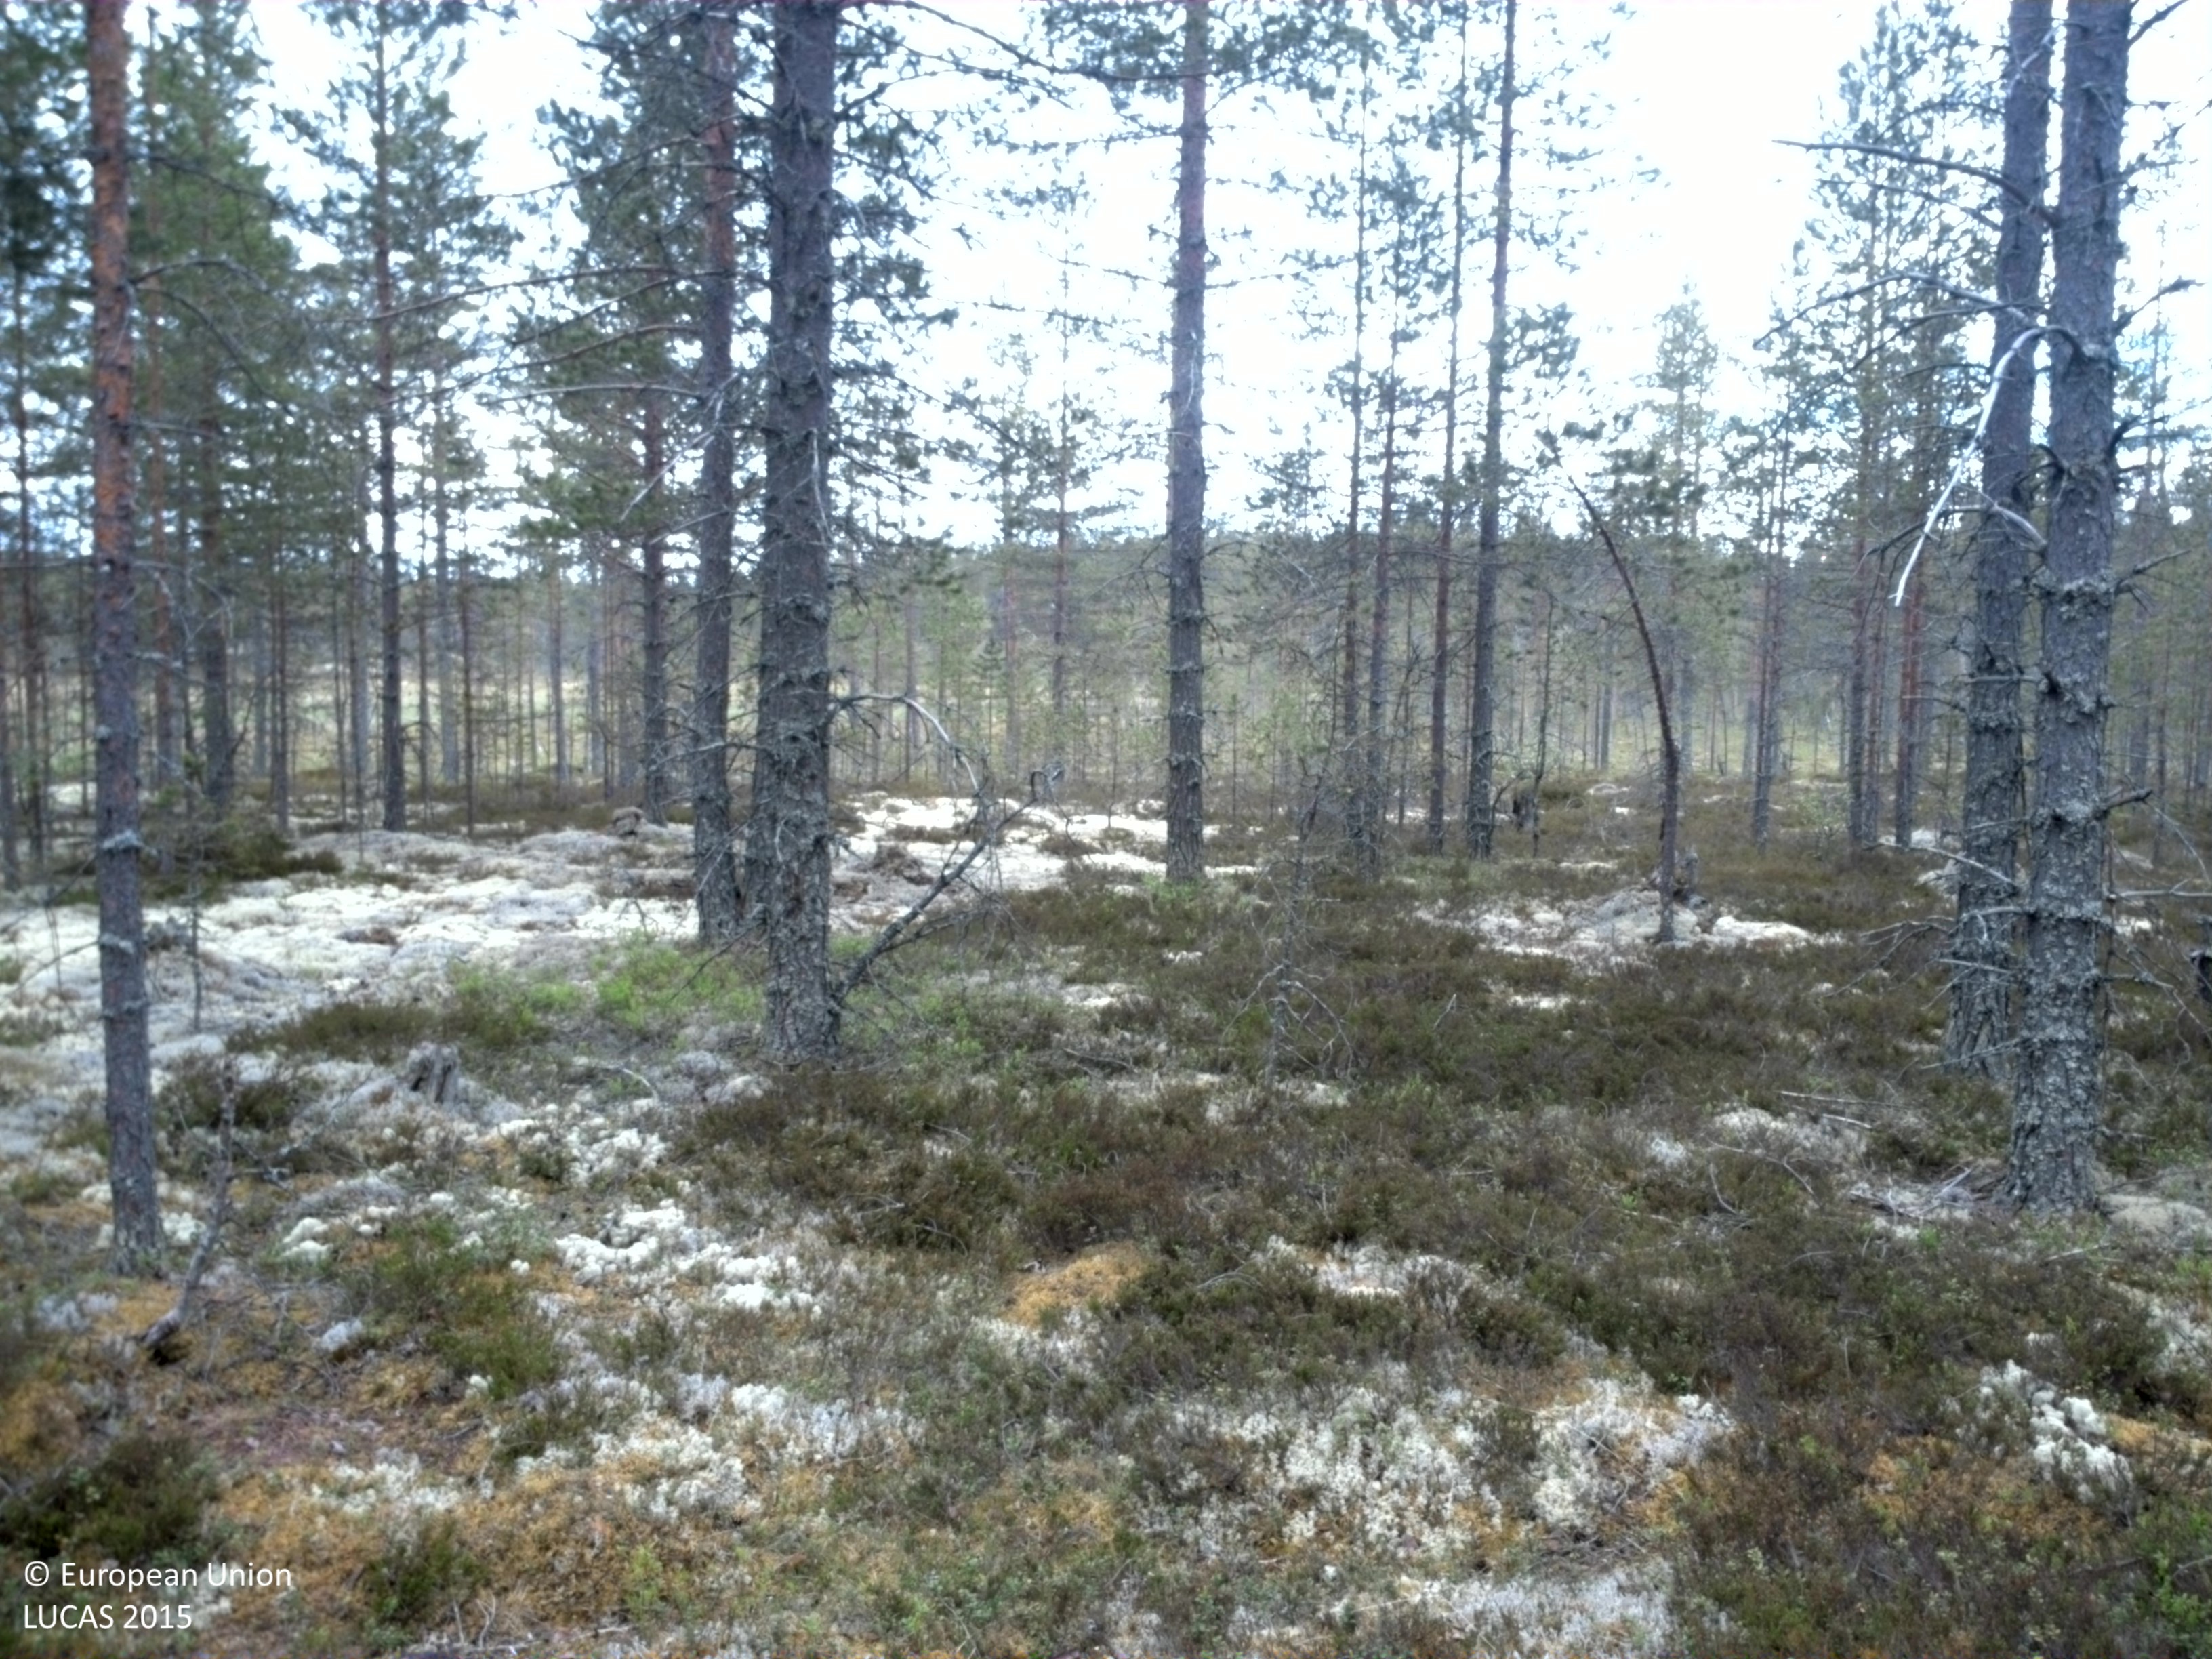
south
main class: Woodland
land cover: Pine dominated coniferous woodland
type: boreal forest
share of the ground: 50 - 75 %
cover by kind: coniferous forest trees 60 %, herbaceous plants 15 %, lichens and mosses 15 %, broadleaved forest trees 10 %
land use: Forestry
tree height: > 5 m
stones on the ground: < 10 %
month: June
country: SE
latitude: 61.1979
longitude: 13.6161
